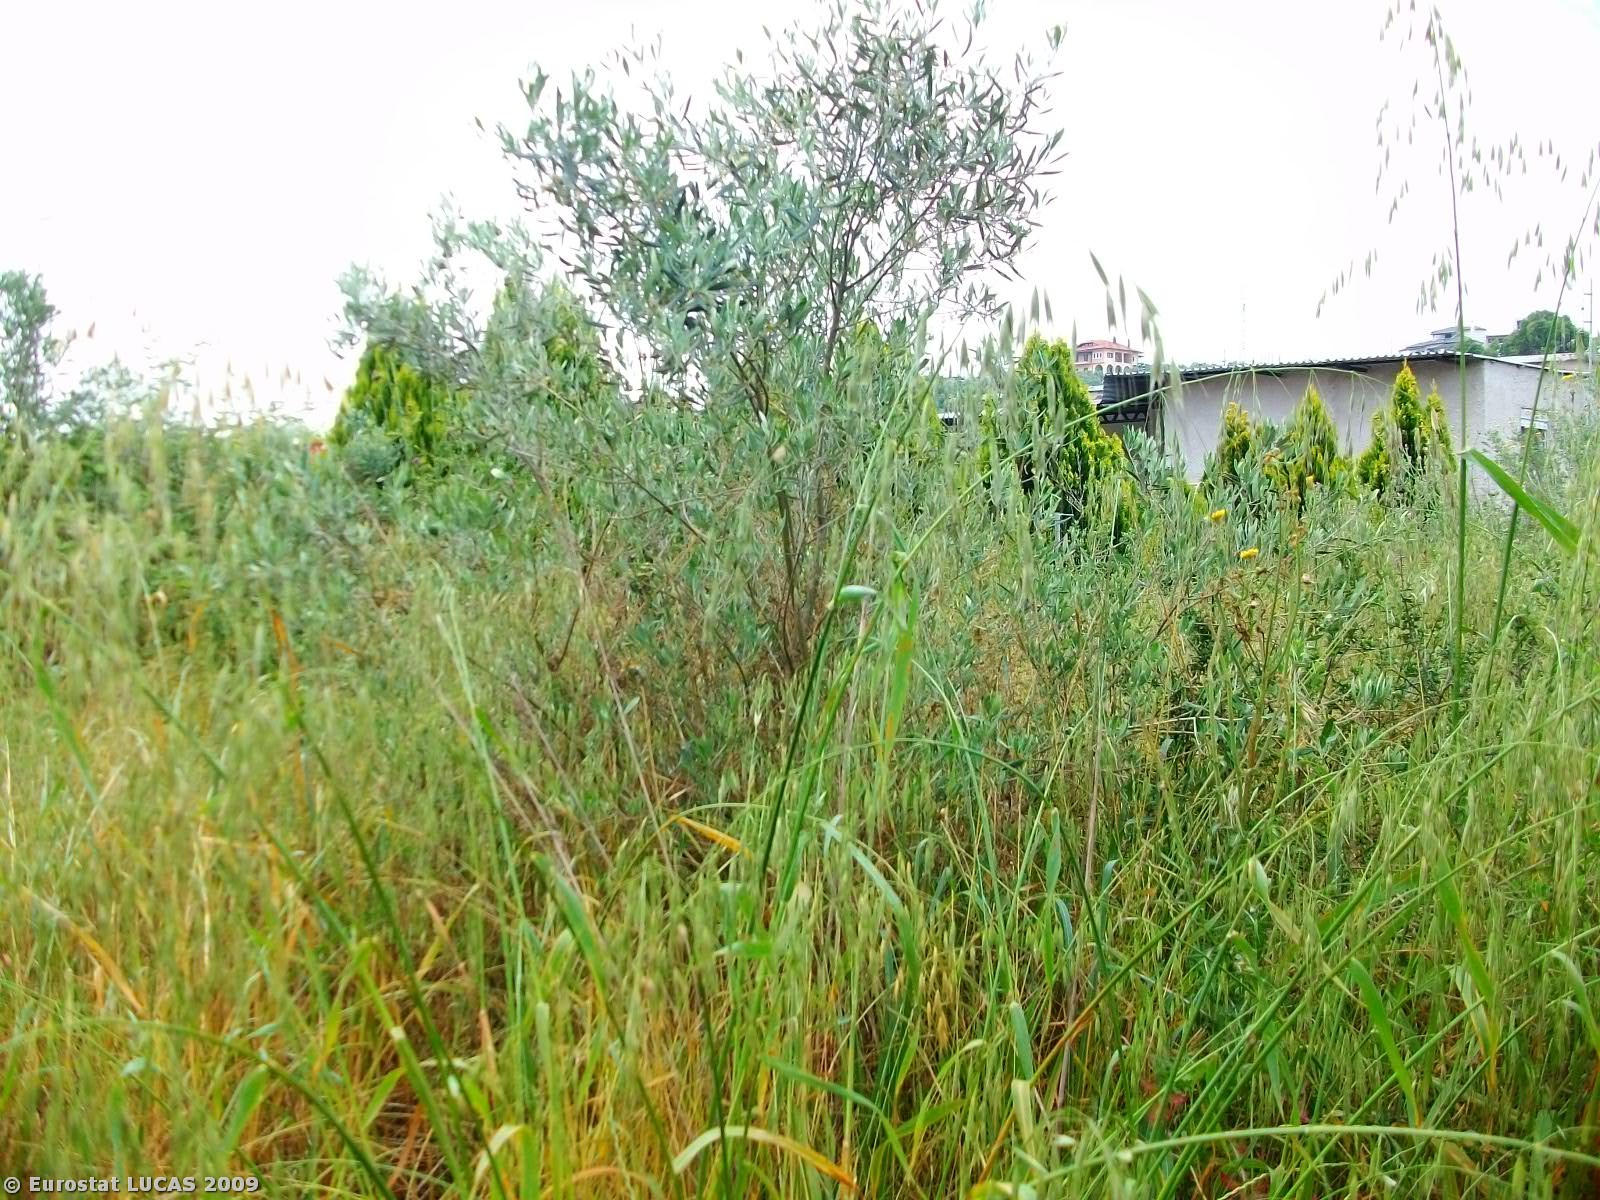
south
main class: Cropland
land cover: Olive groves
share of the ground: 50 - 75 %
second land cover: Grassland with sparse tree/shrub cover
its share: > 75 %
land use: Agriculture (excluding fallow land and kitchen gardens)
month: June
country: GR
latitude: 40.3197
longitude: 22.5323
